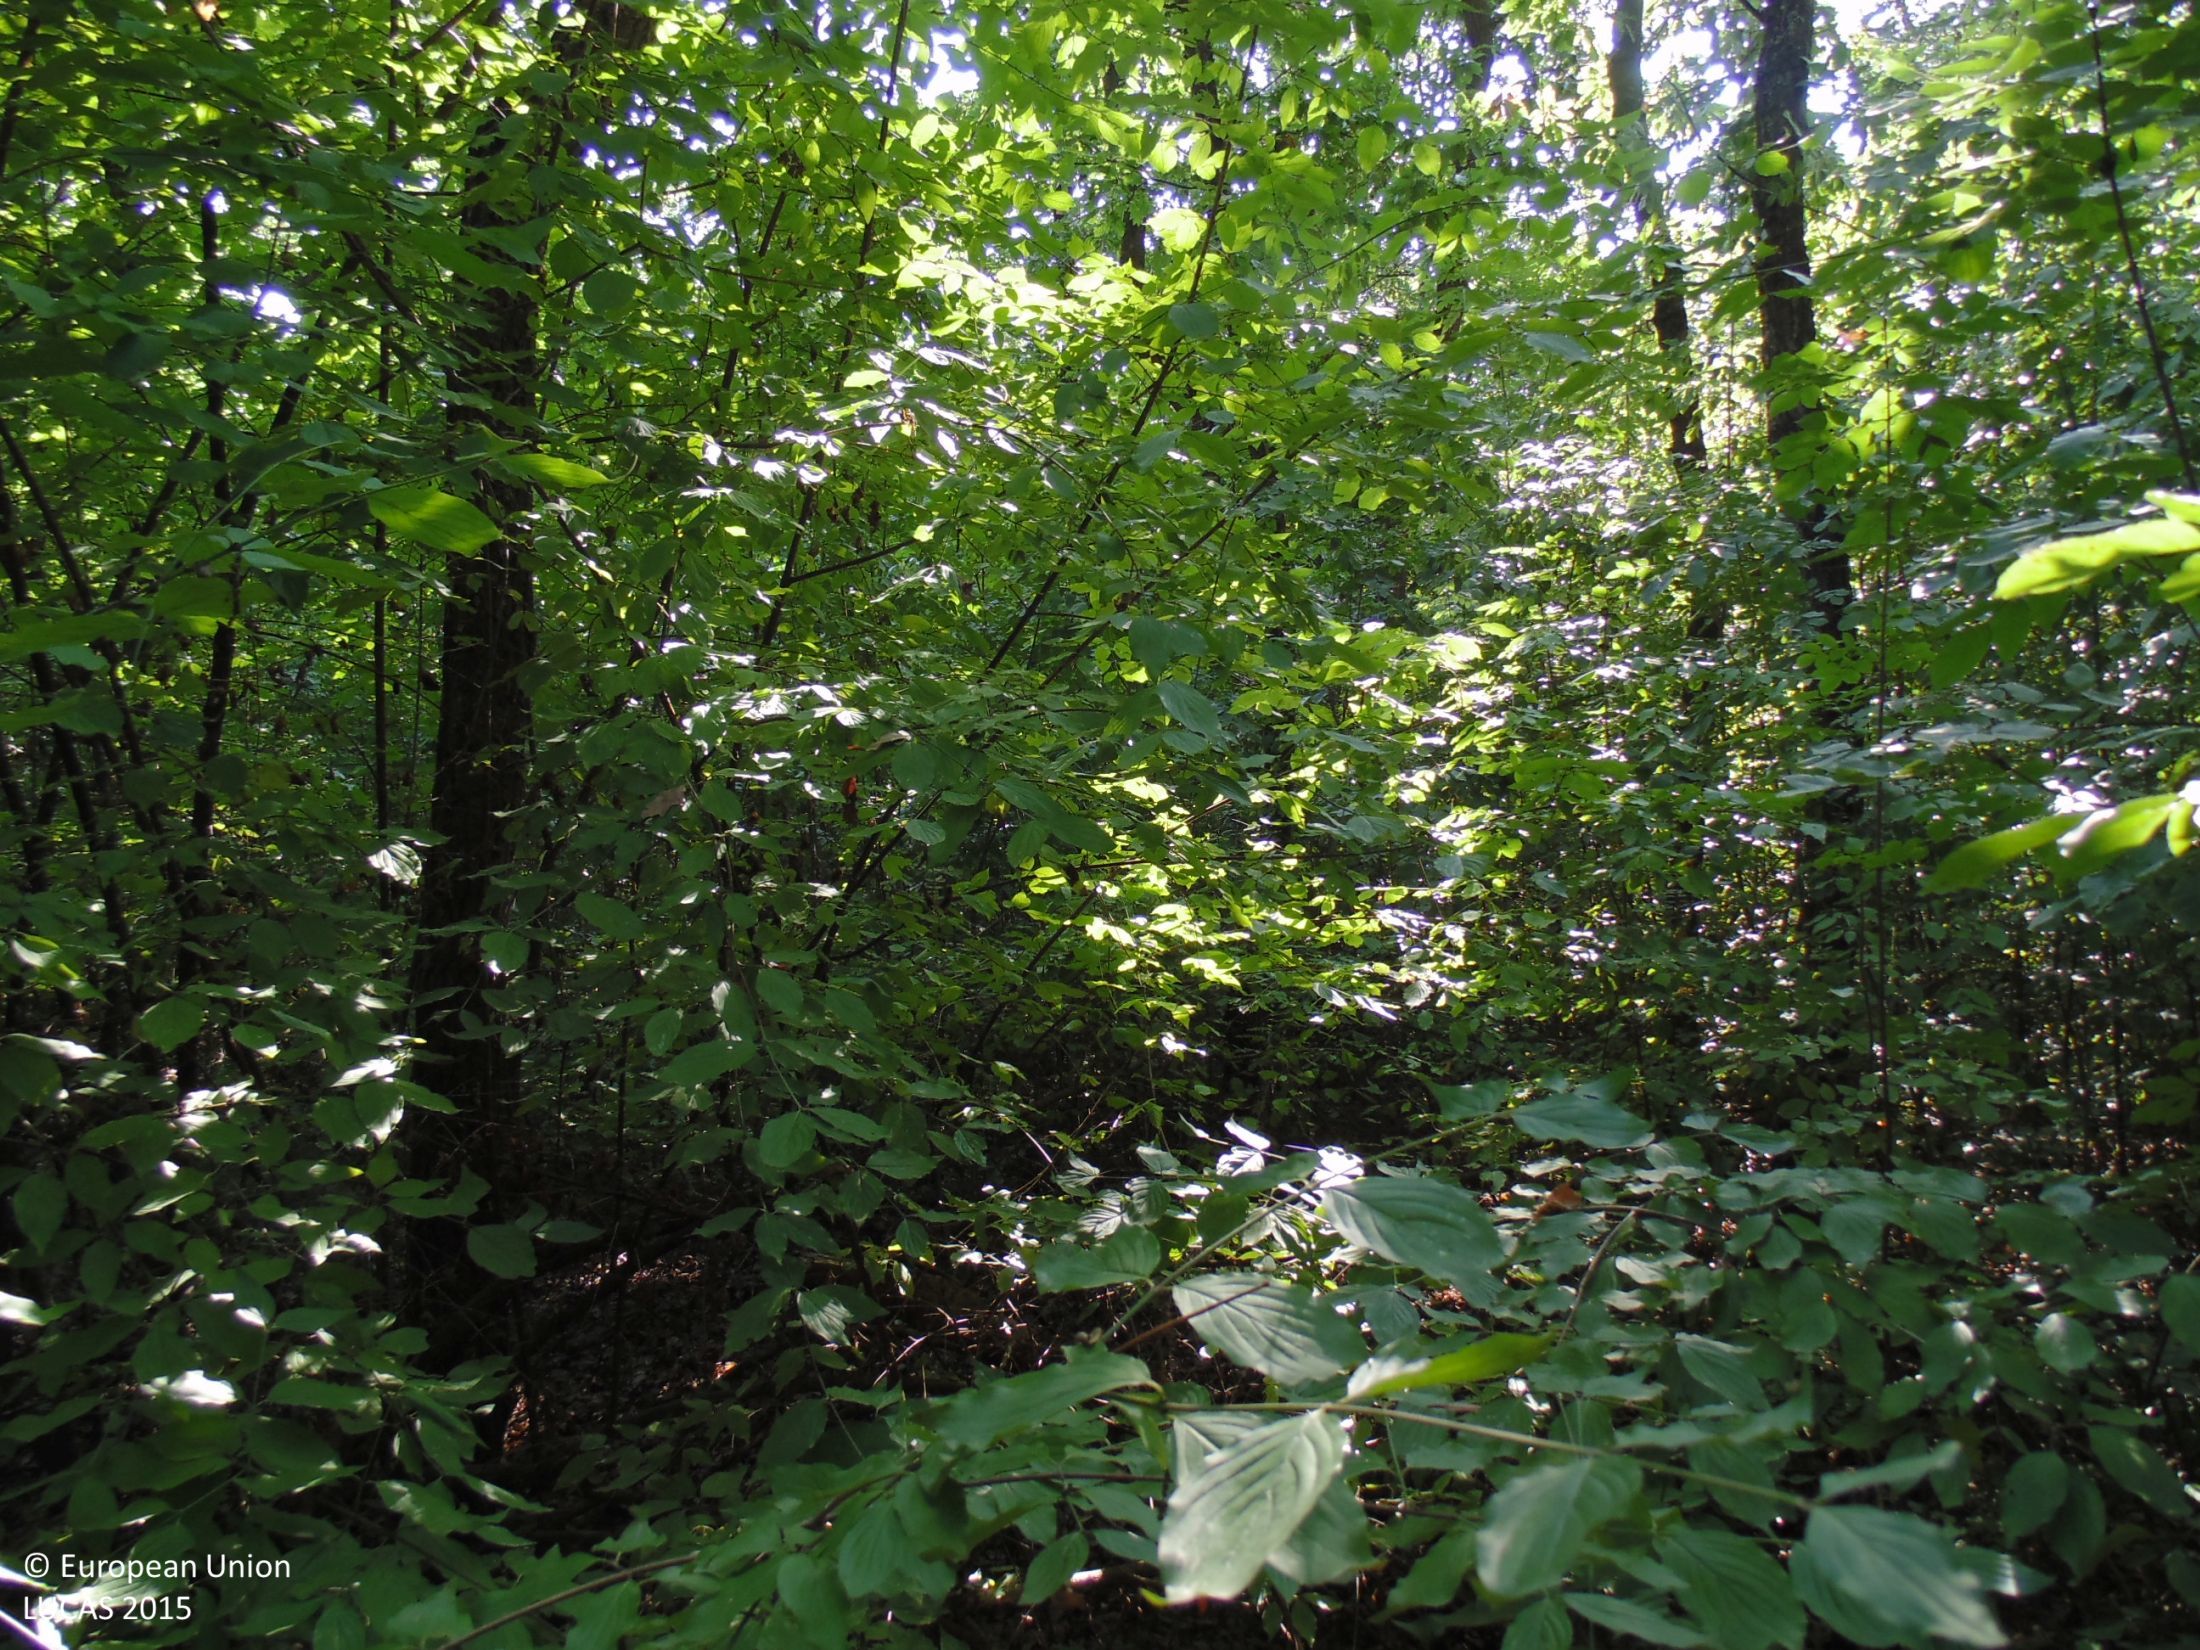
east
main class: Woodland
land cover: Broadleaved woodland
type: mesophytic deciduous forest
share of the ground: > 75 %
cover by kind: broadleaved forest trees 90 %, shrubs 5 %, unconsolidated bare surface 5 %
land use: Forestry
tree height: > 5 m
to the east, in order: Broadleaved woodland
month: August
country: BG
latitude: 43.8463
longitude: 27.4871
